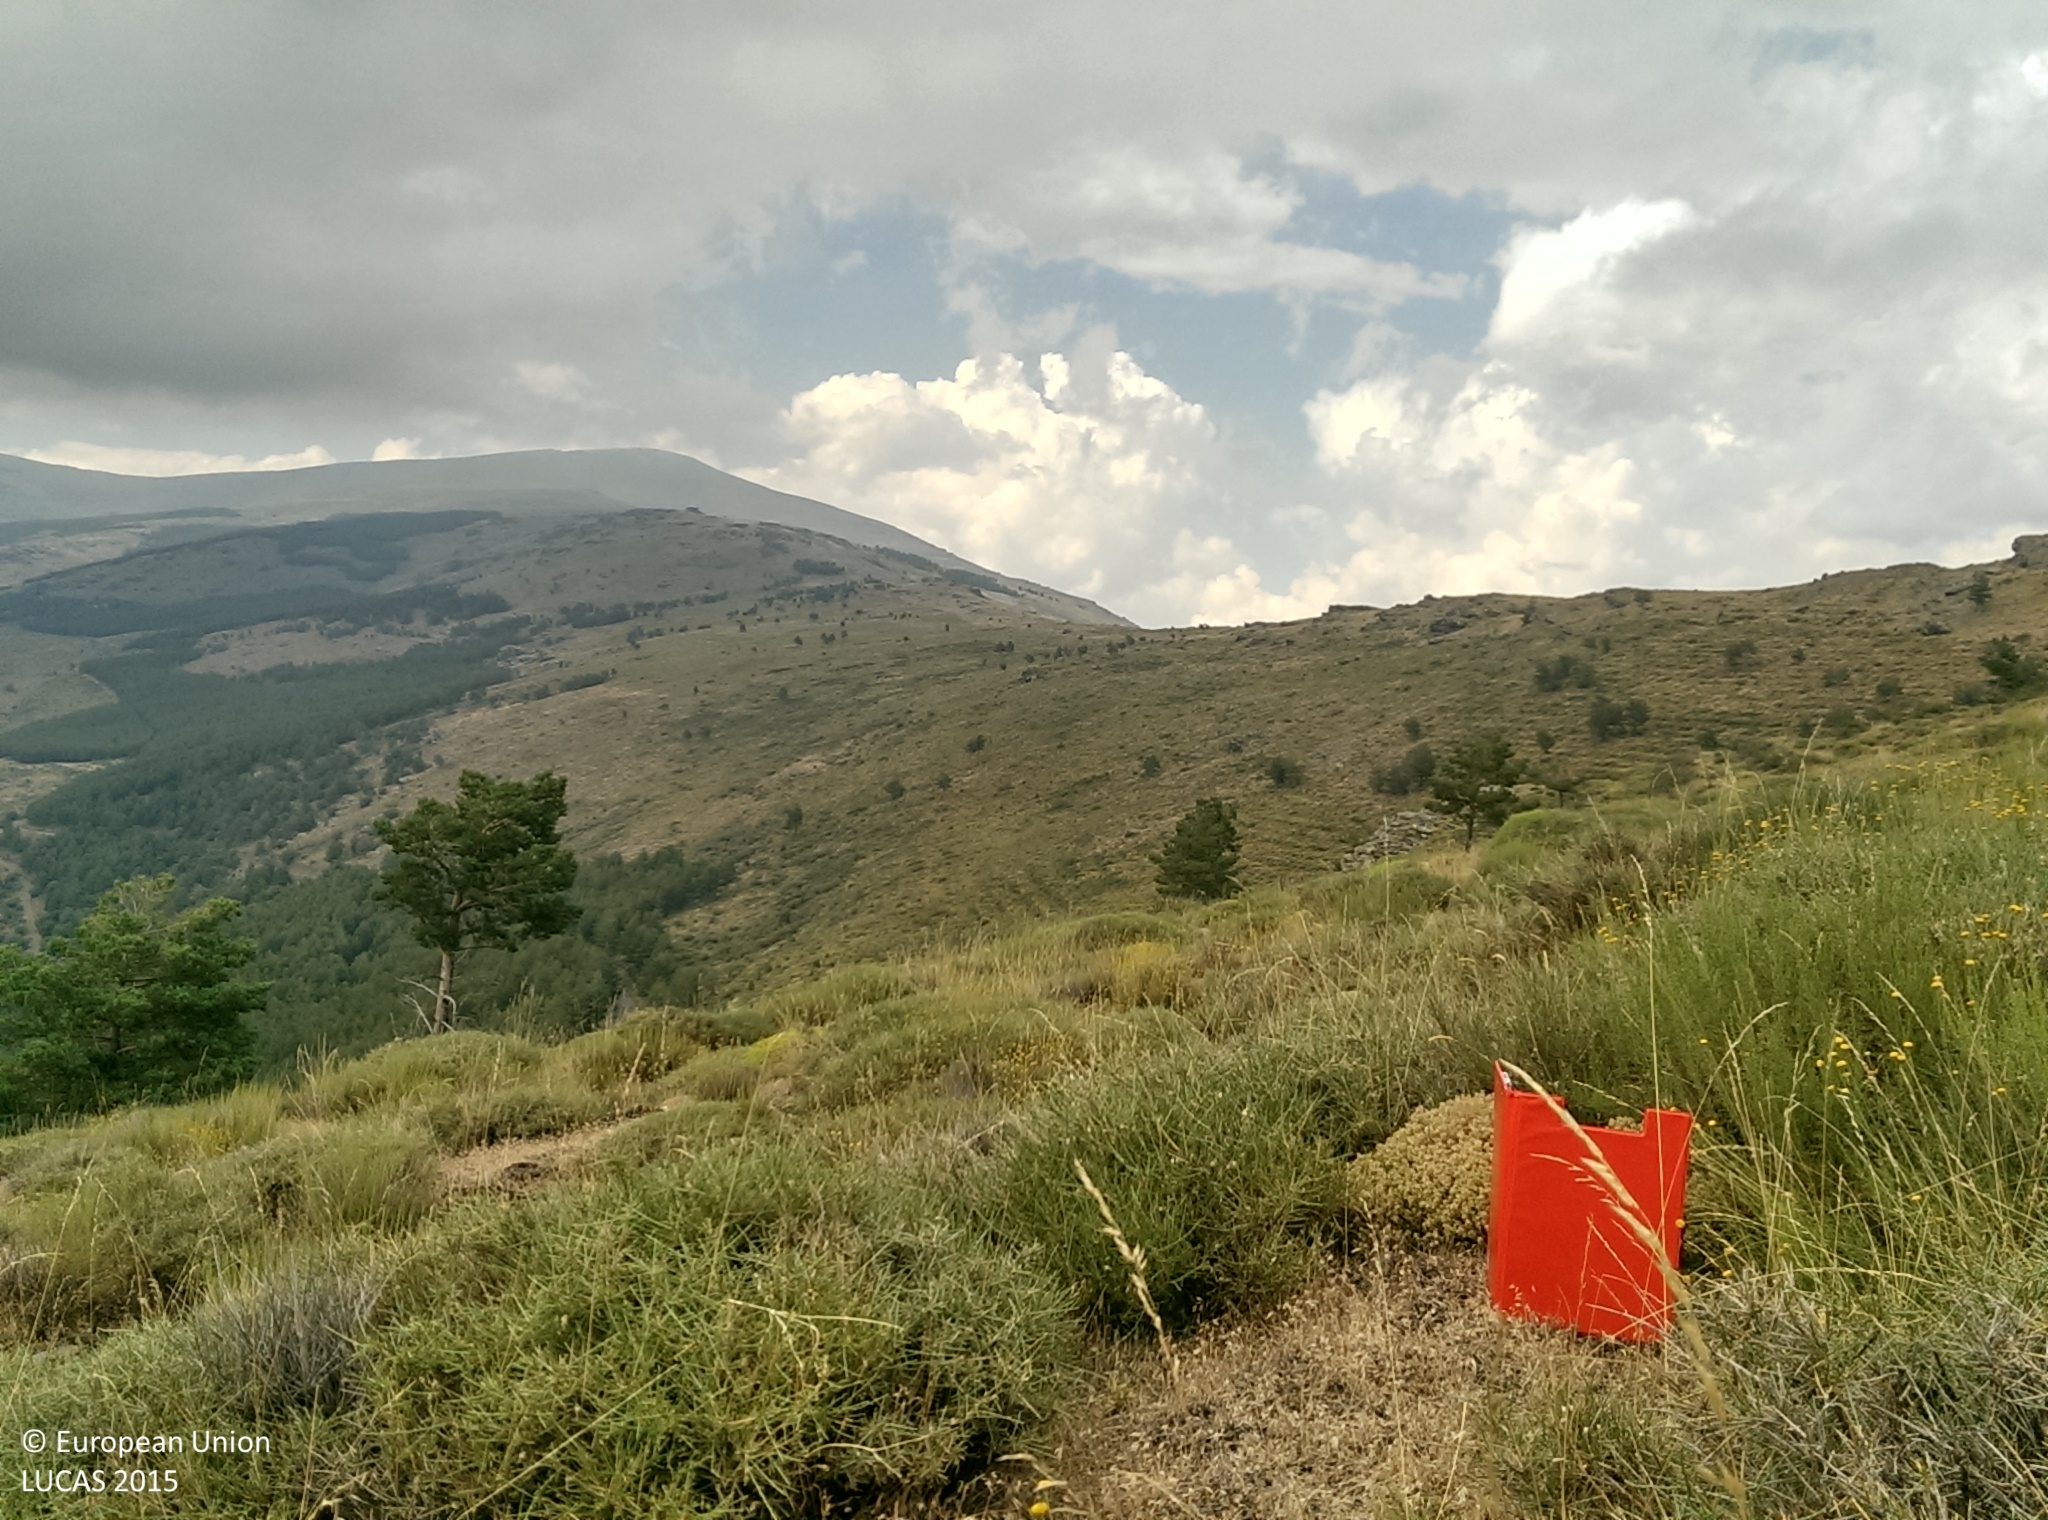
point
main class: Shrubland
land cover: Shrubland without tree cover
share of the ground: > 75 %
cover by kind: shrubs 80 %, herbaceous plants 10 %, unconsolidated bare surface 10 %
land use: Forestry
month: July
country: ES
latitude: 37.0354
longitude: -3.1250
